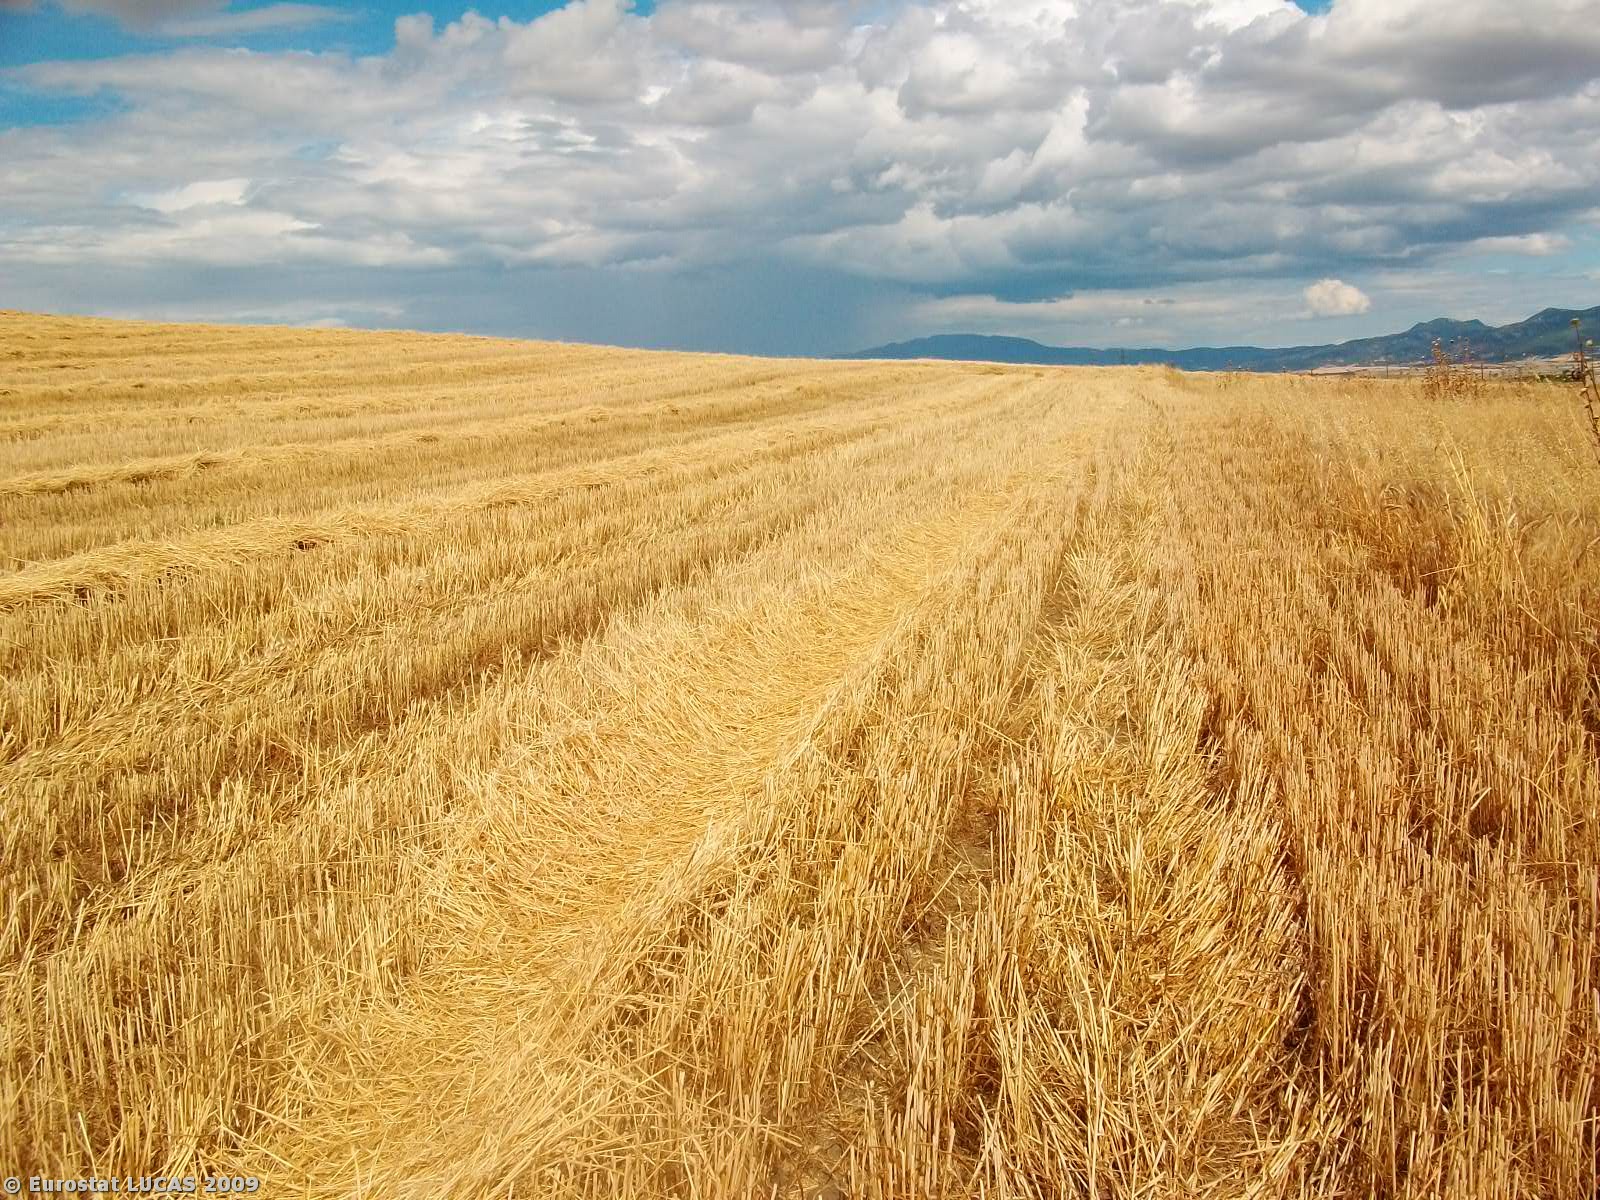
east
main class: Grassland
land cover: Spontaneously vegetated surfaces
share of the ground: > 75 %
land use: Unused
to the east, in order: Spontaneously vegetated surfaces; Tracks; Other root crops; Shruby margins; Tracks; Shruby margins; Common wheat; Grassland with sparse tree/shrub cover; Common wheat
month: June
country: GR
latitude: 39.0886
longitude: 22.2945
